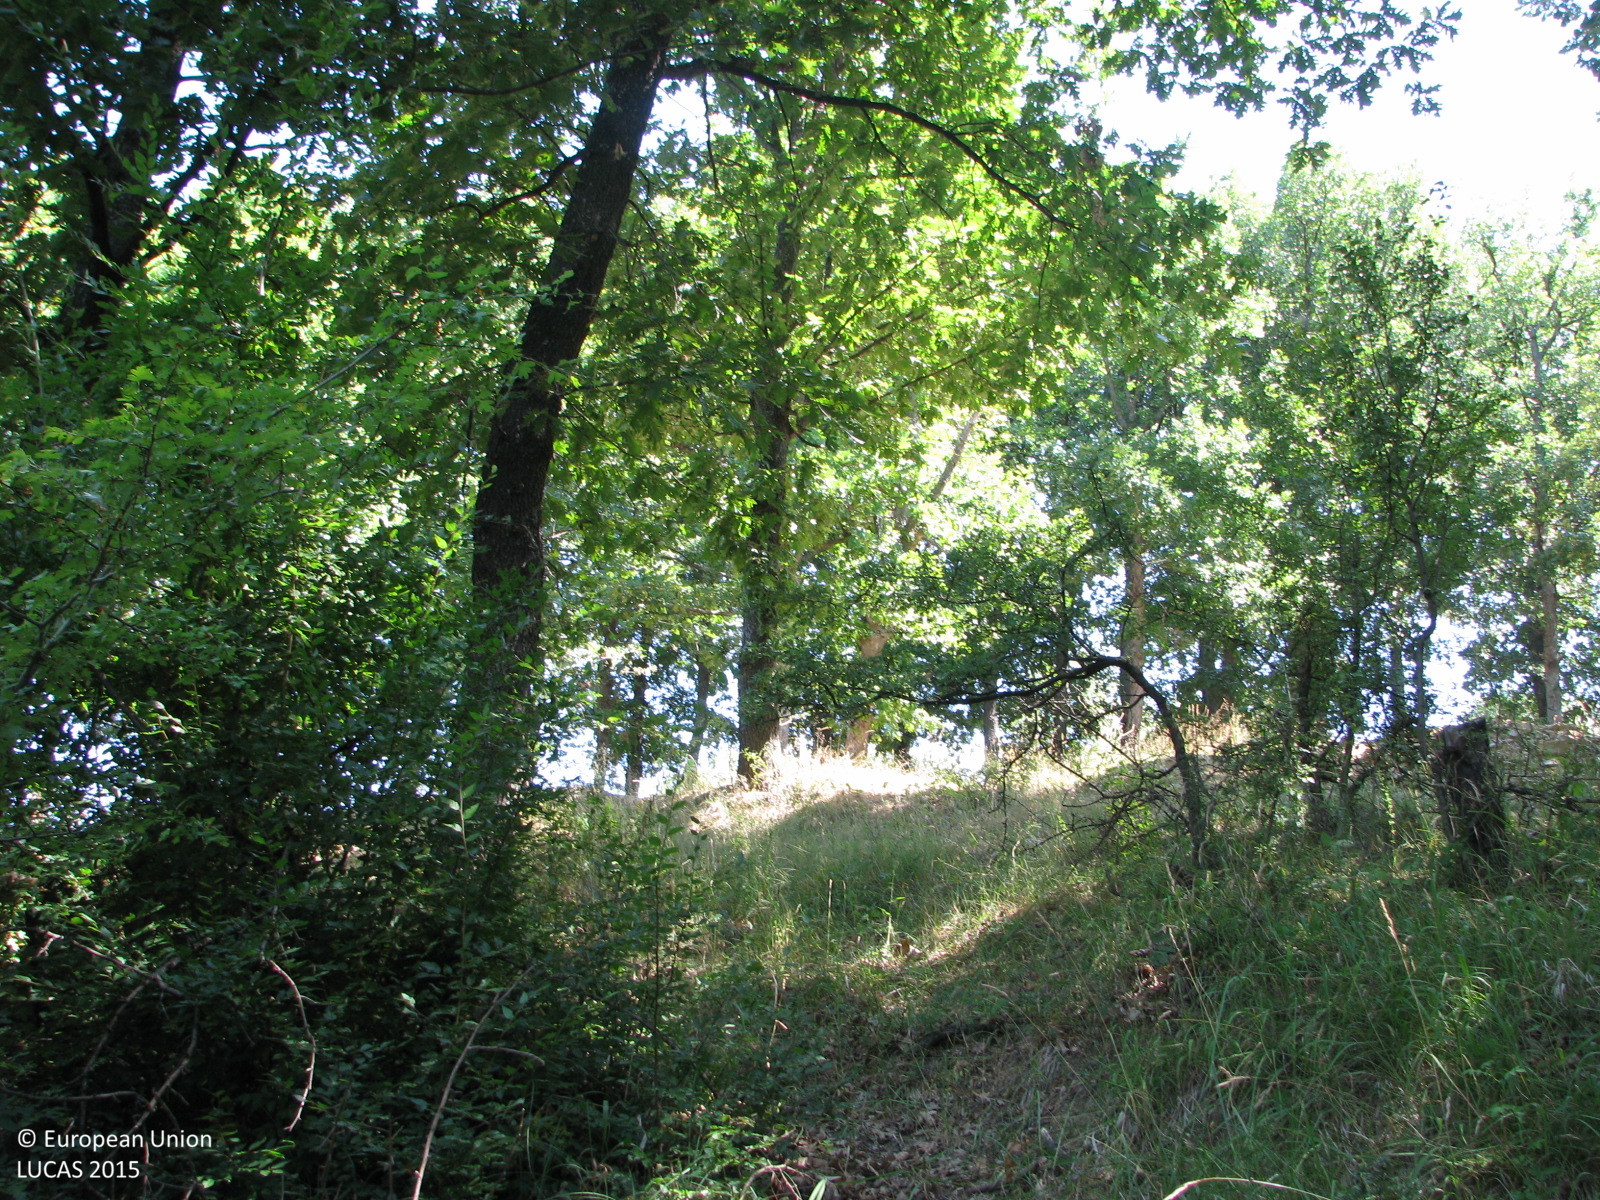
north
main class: Woodland
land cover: Broadleaved woodland
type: thermophilous deciduous forest
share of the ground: 25 - 50 %
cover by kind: herbaceous plants 50 %, broadleaved forest trees 40 %, shrubs 10 %
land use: Forestry
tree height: > 5 m
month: August
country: BG
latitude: 42.7659
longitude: 26.1325
